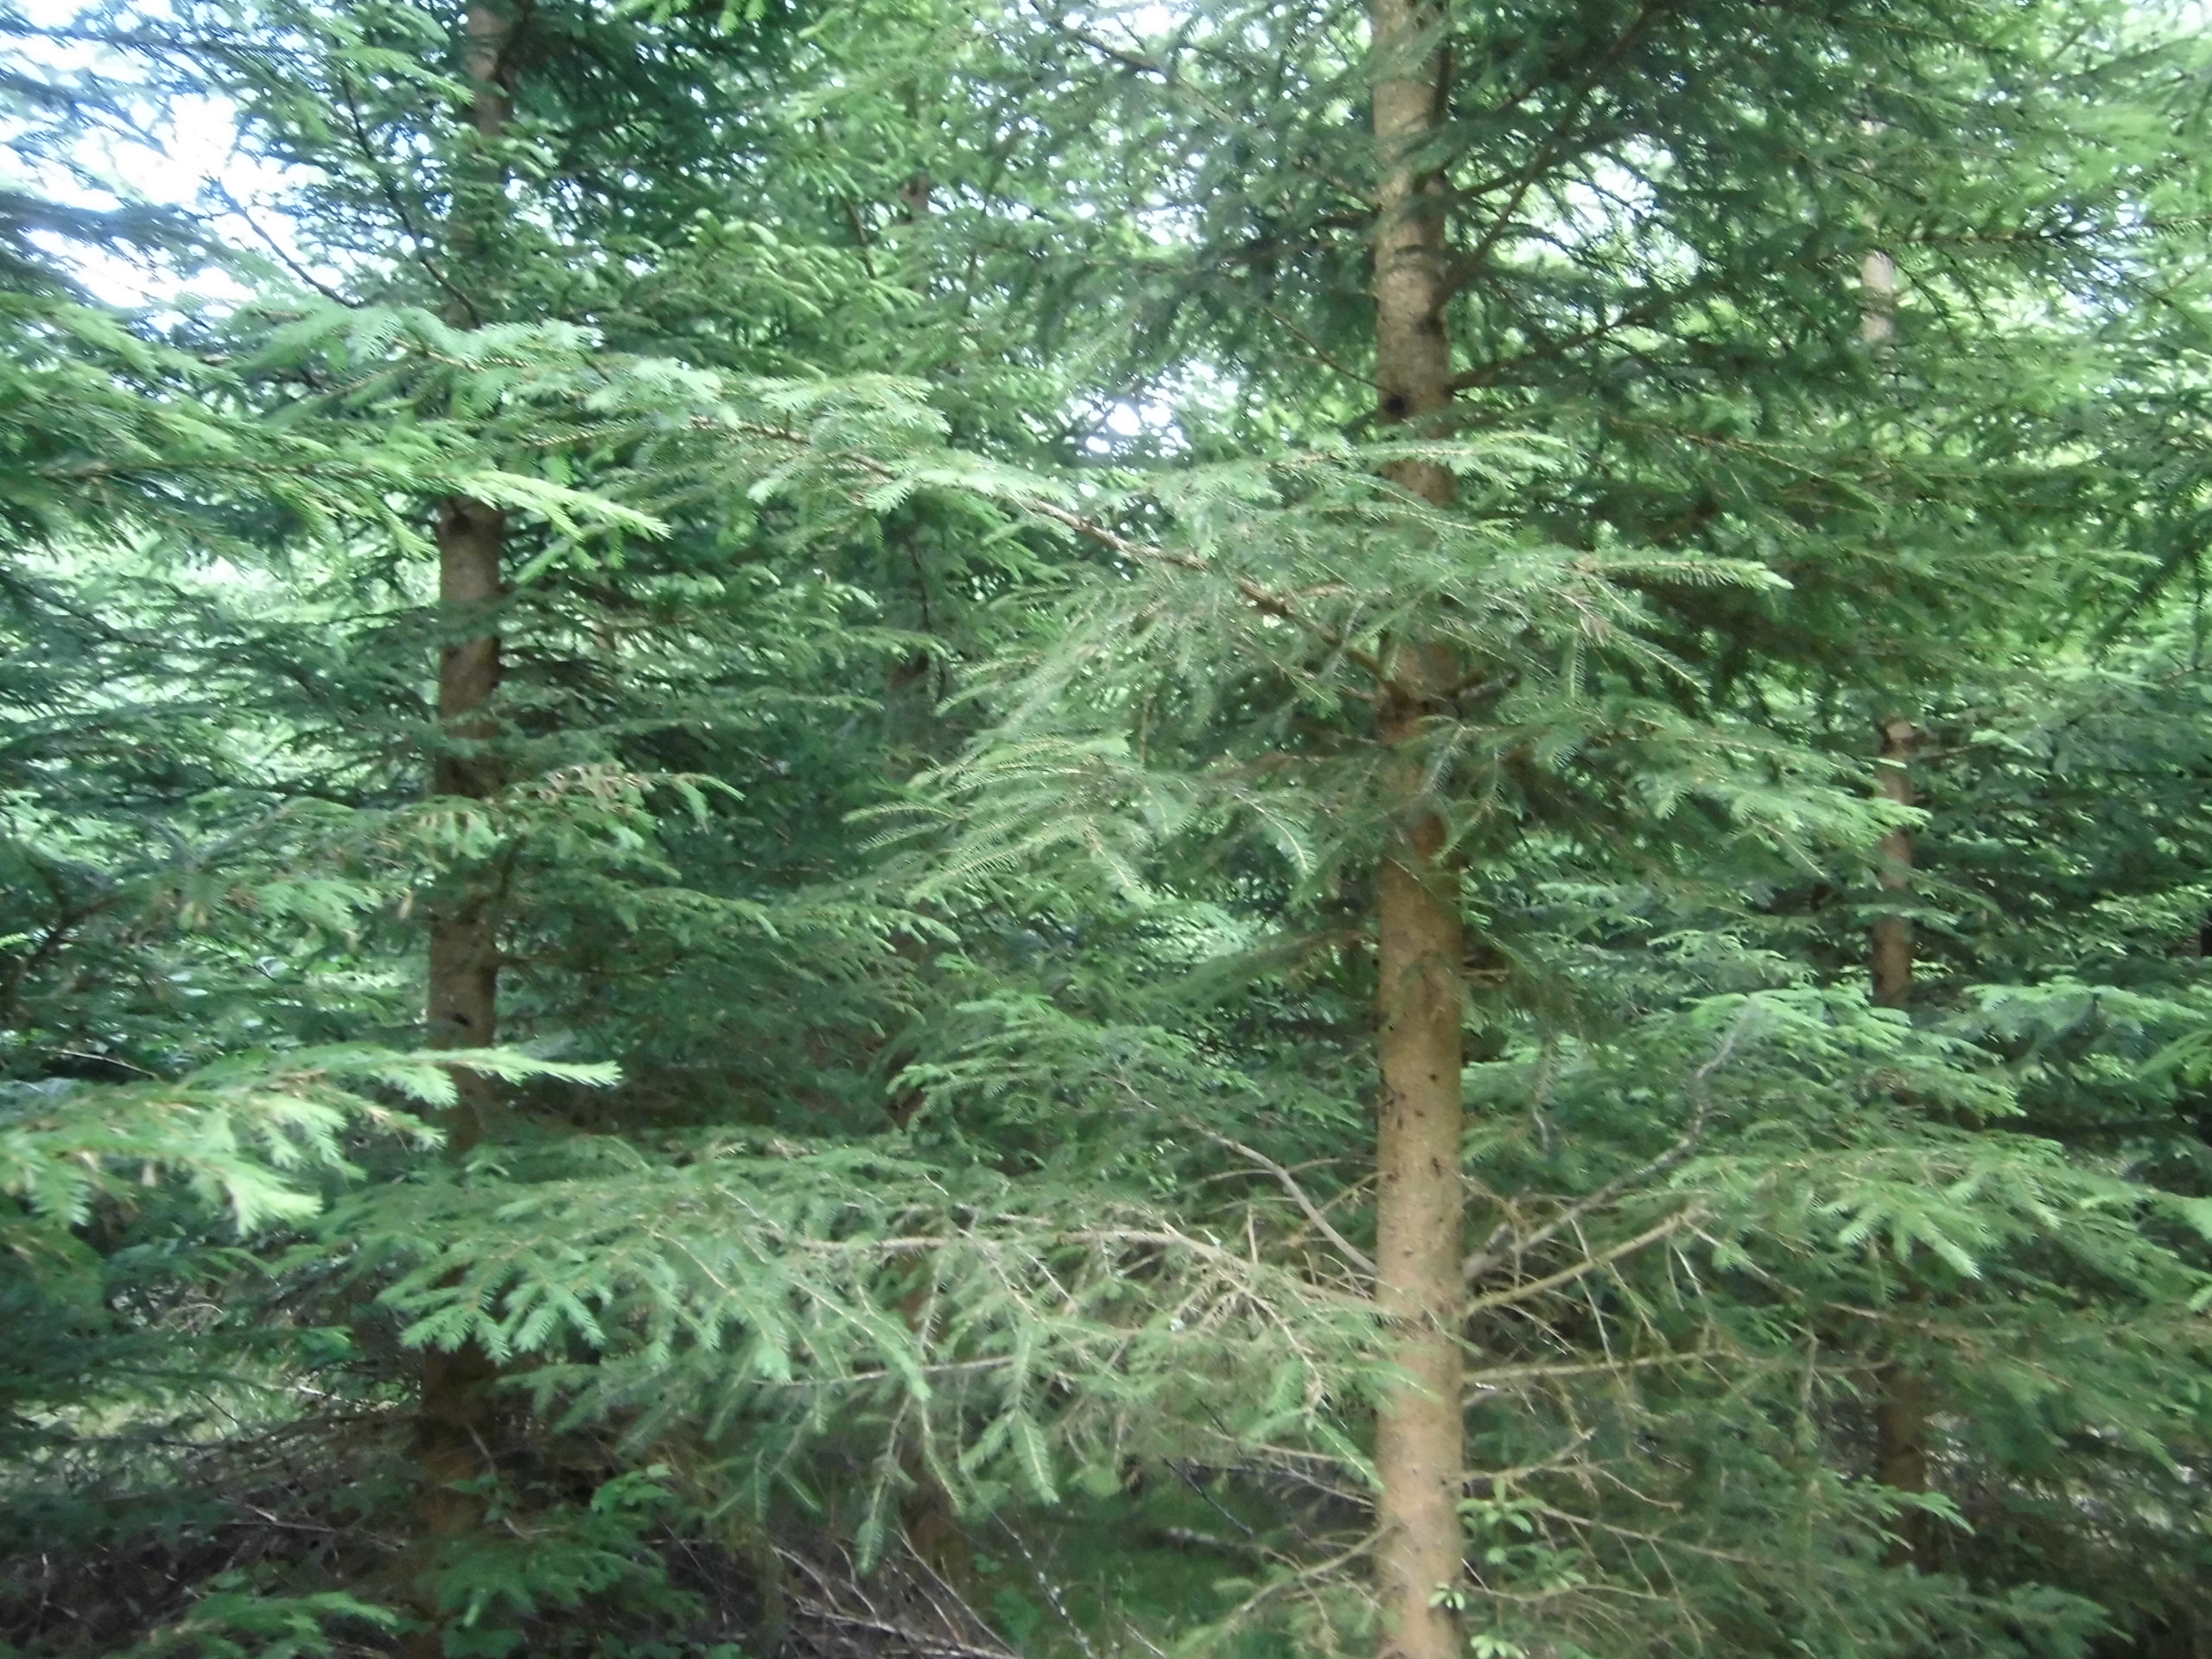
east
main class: Woodland
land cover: Spruce dominated coniferous woodland
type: boreal forest
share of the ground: 50 - 75 %
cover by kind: coniferous forest trees 60 %, herbaceous plants 15 %, broadleaved forest trees 10 %, lichens and mosses 10 %, shrubs 5 %
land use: Forestry
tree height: > 5 m
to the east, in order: Spruce dominated coniferous woodland; Tracks; Spruce dominated mixed woodland; Ditches and canals; Grassland without tree/shrub cover; Ditches and canals; Barley
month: July
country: SE
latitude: 57.4690
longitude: 14.7477
